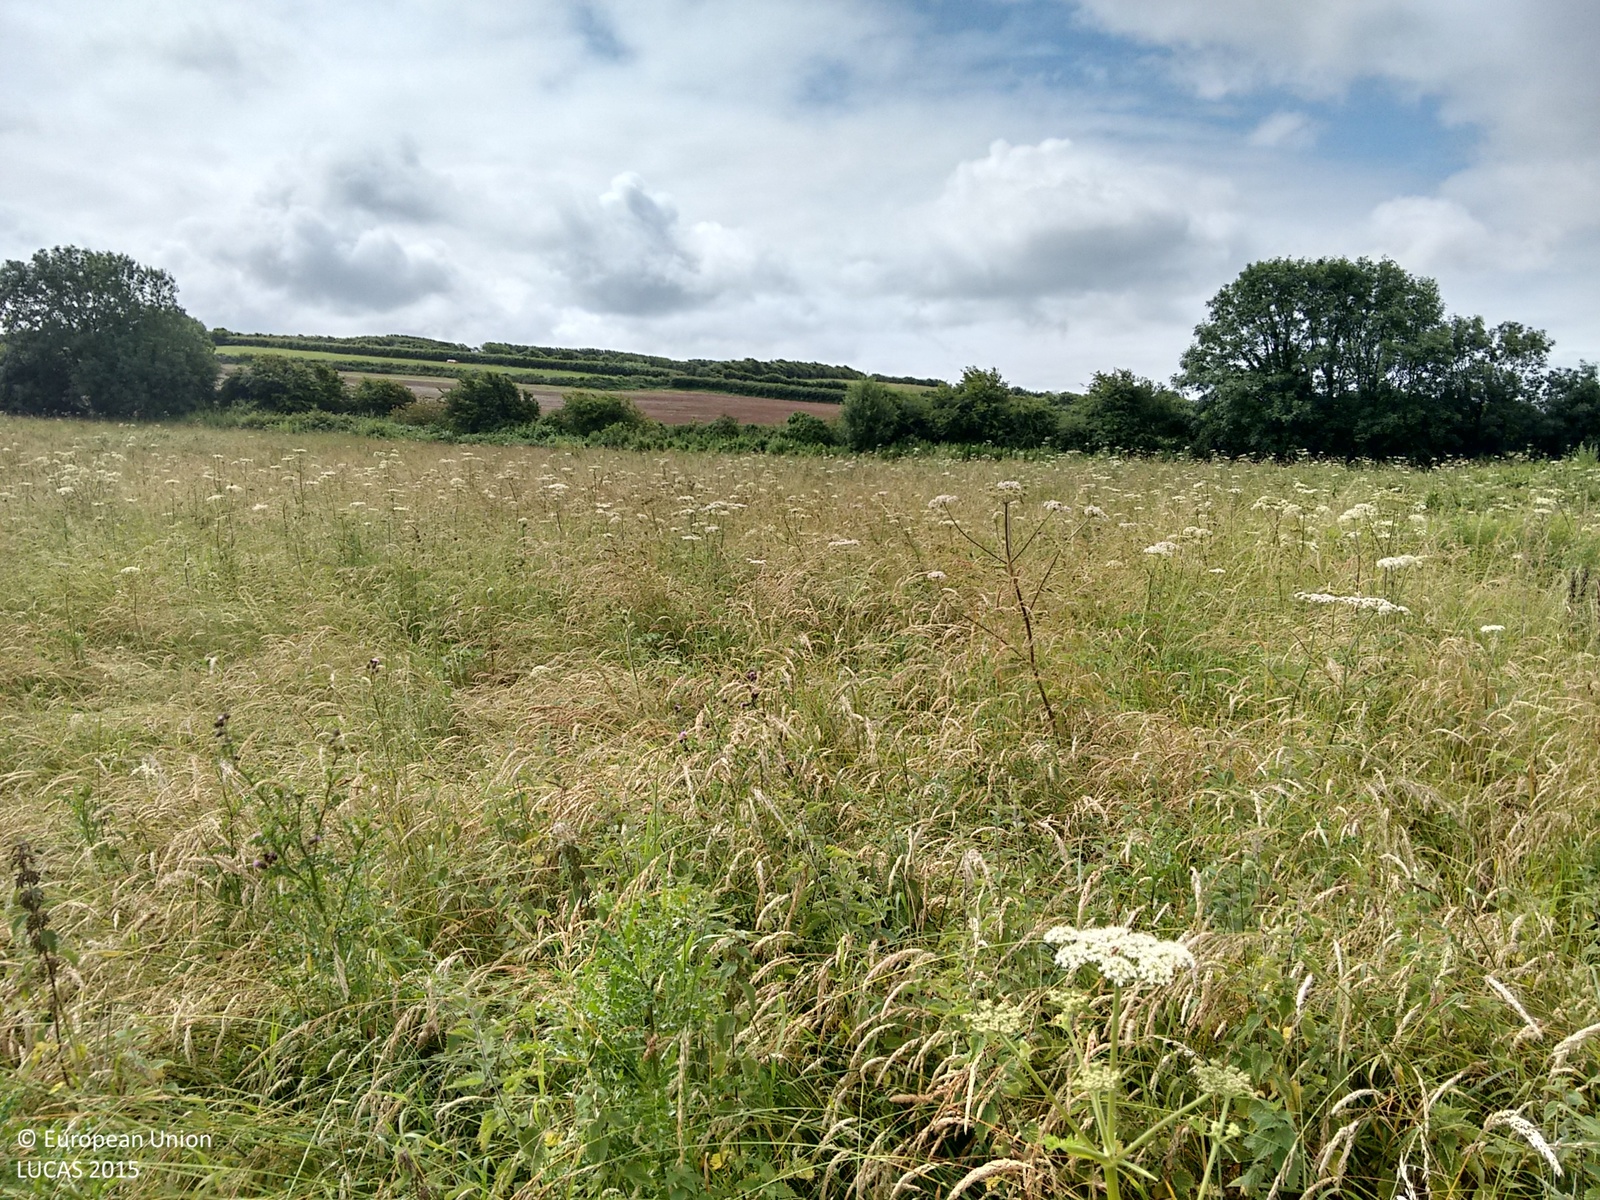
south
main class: Grassland
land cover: Grassland without tree/shrub cover
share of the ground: > 75 %
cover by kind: herbaceous plants 100 %
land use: Abandoned areas
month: July
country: GB
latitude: 51.4939
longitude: -3.6410
